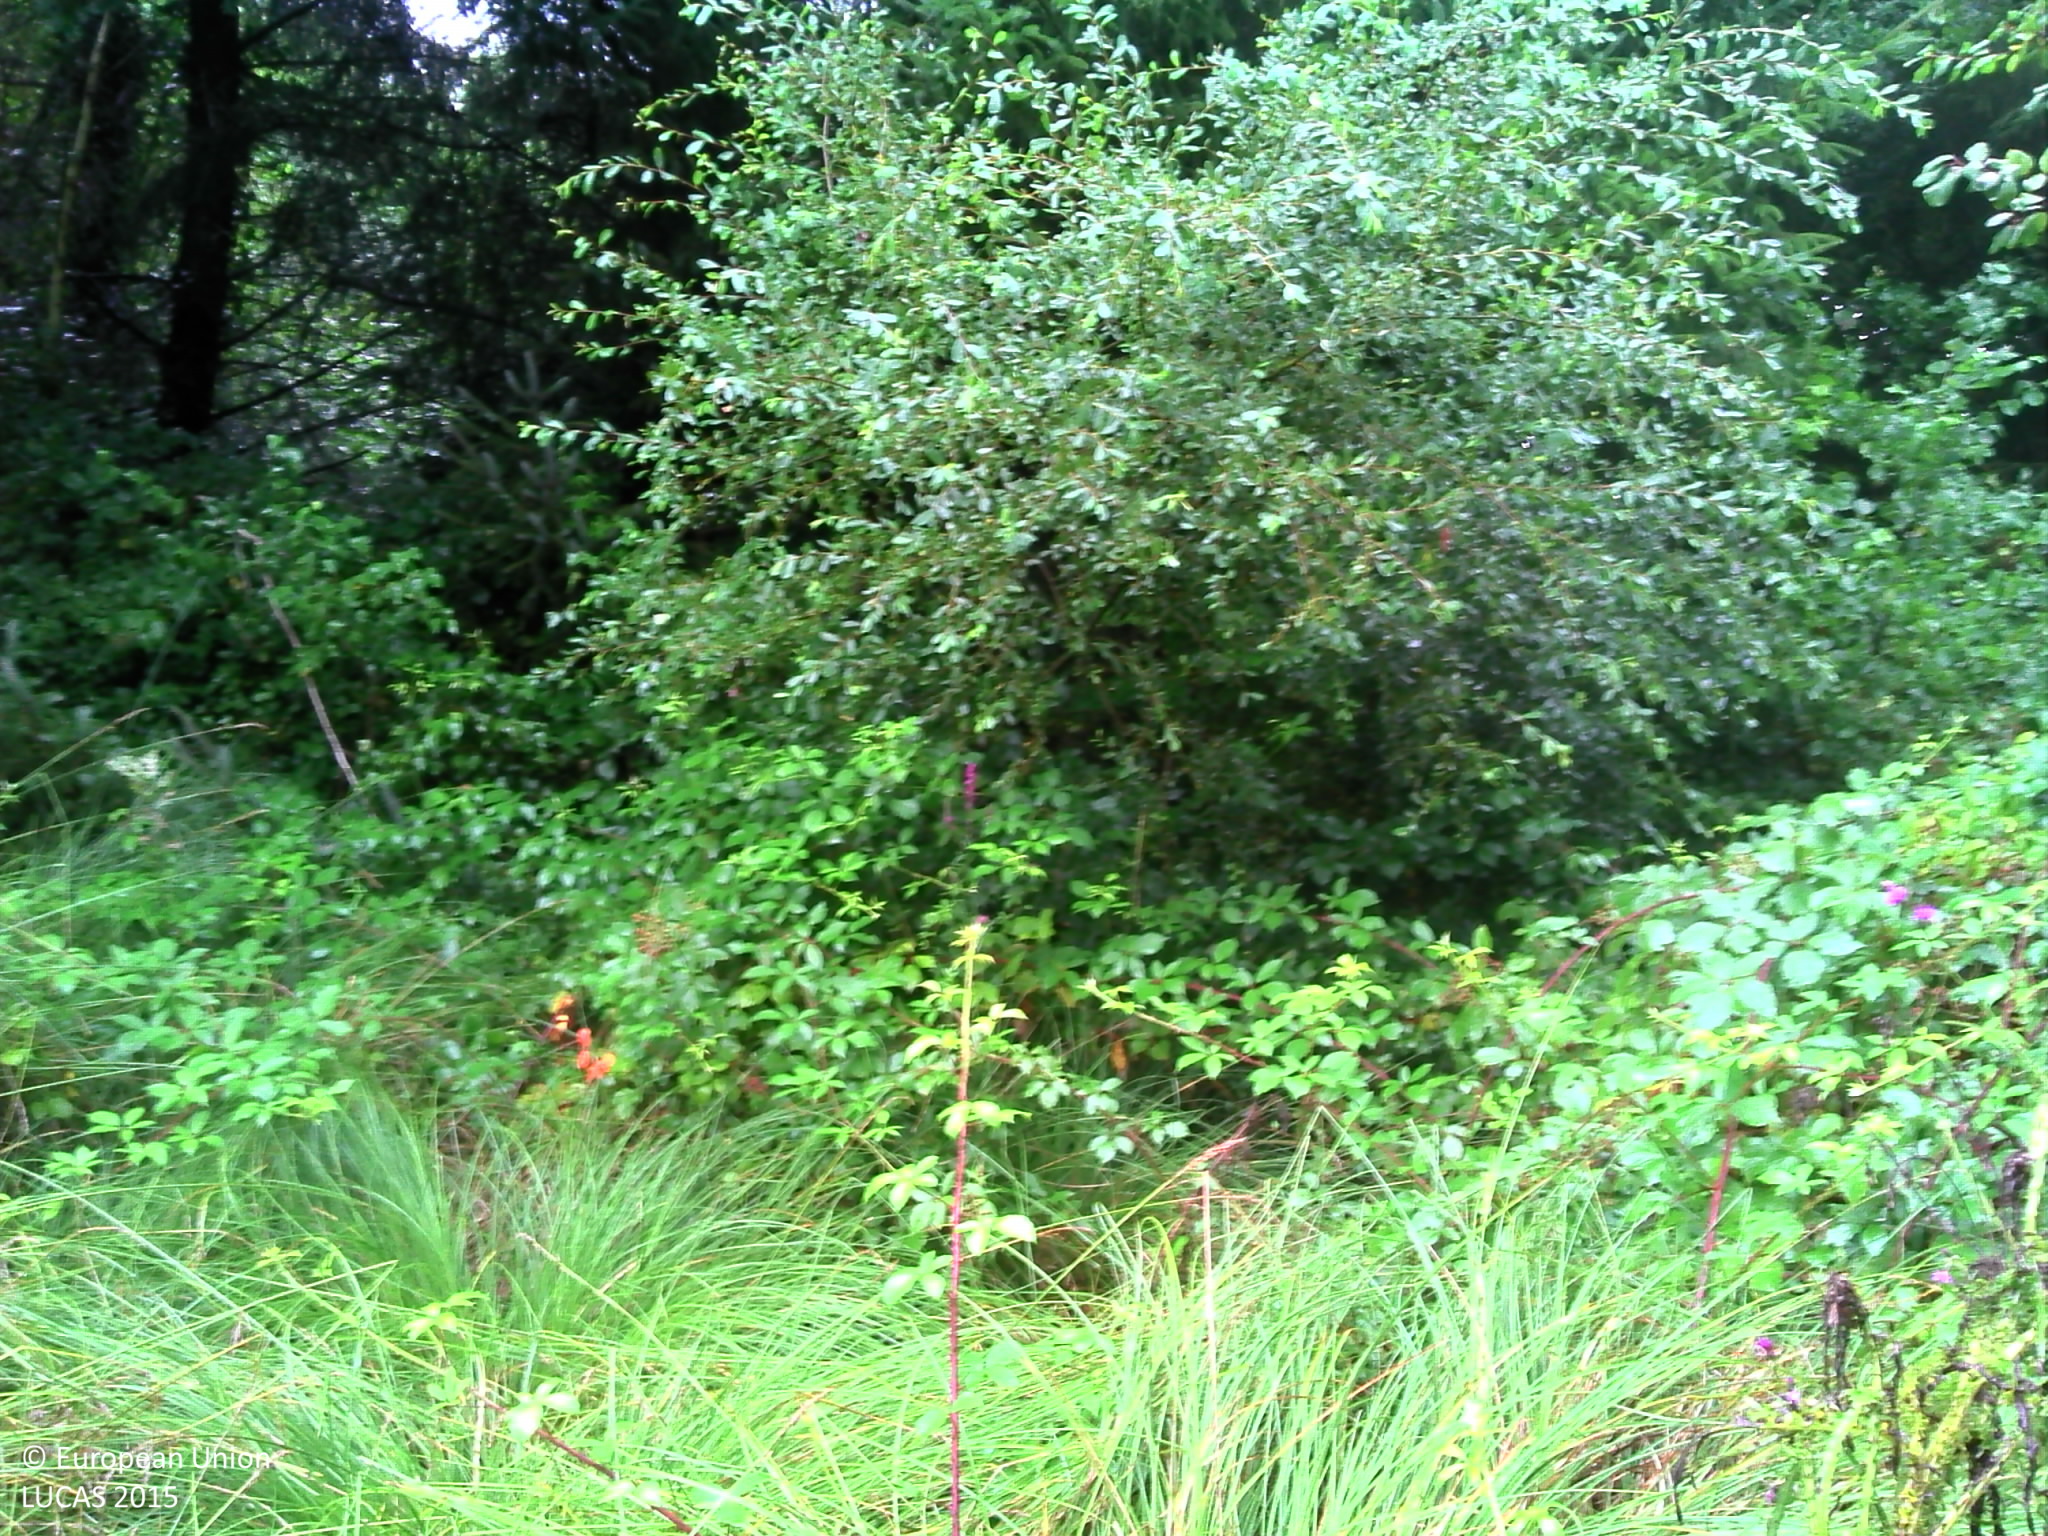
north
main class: Grassland
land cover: Grassland without tree/shrub cover
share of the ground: > 75 %
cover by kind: herbaceous plants 95 %, shrubs 5 %
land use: Forestry
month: August
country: FR
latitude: 45.5489
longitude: 0.7277
